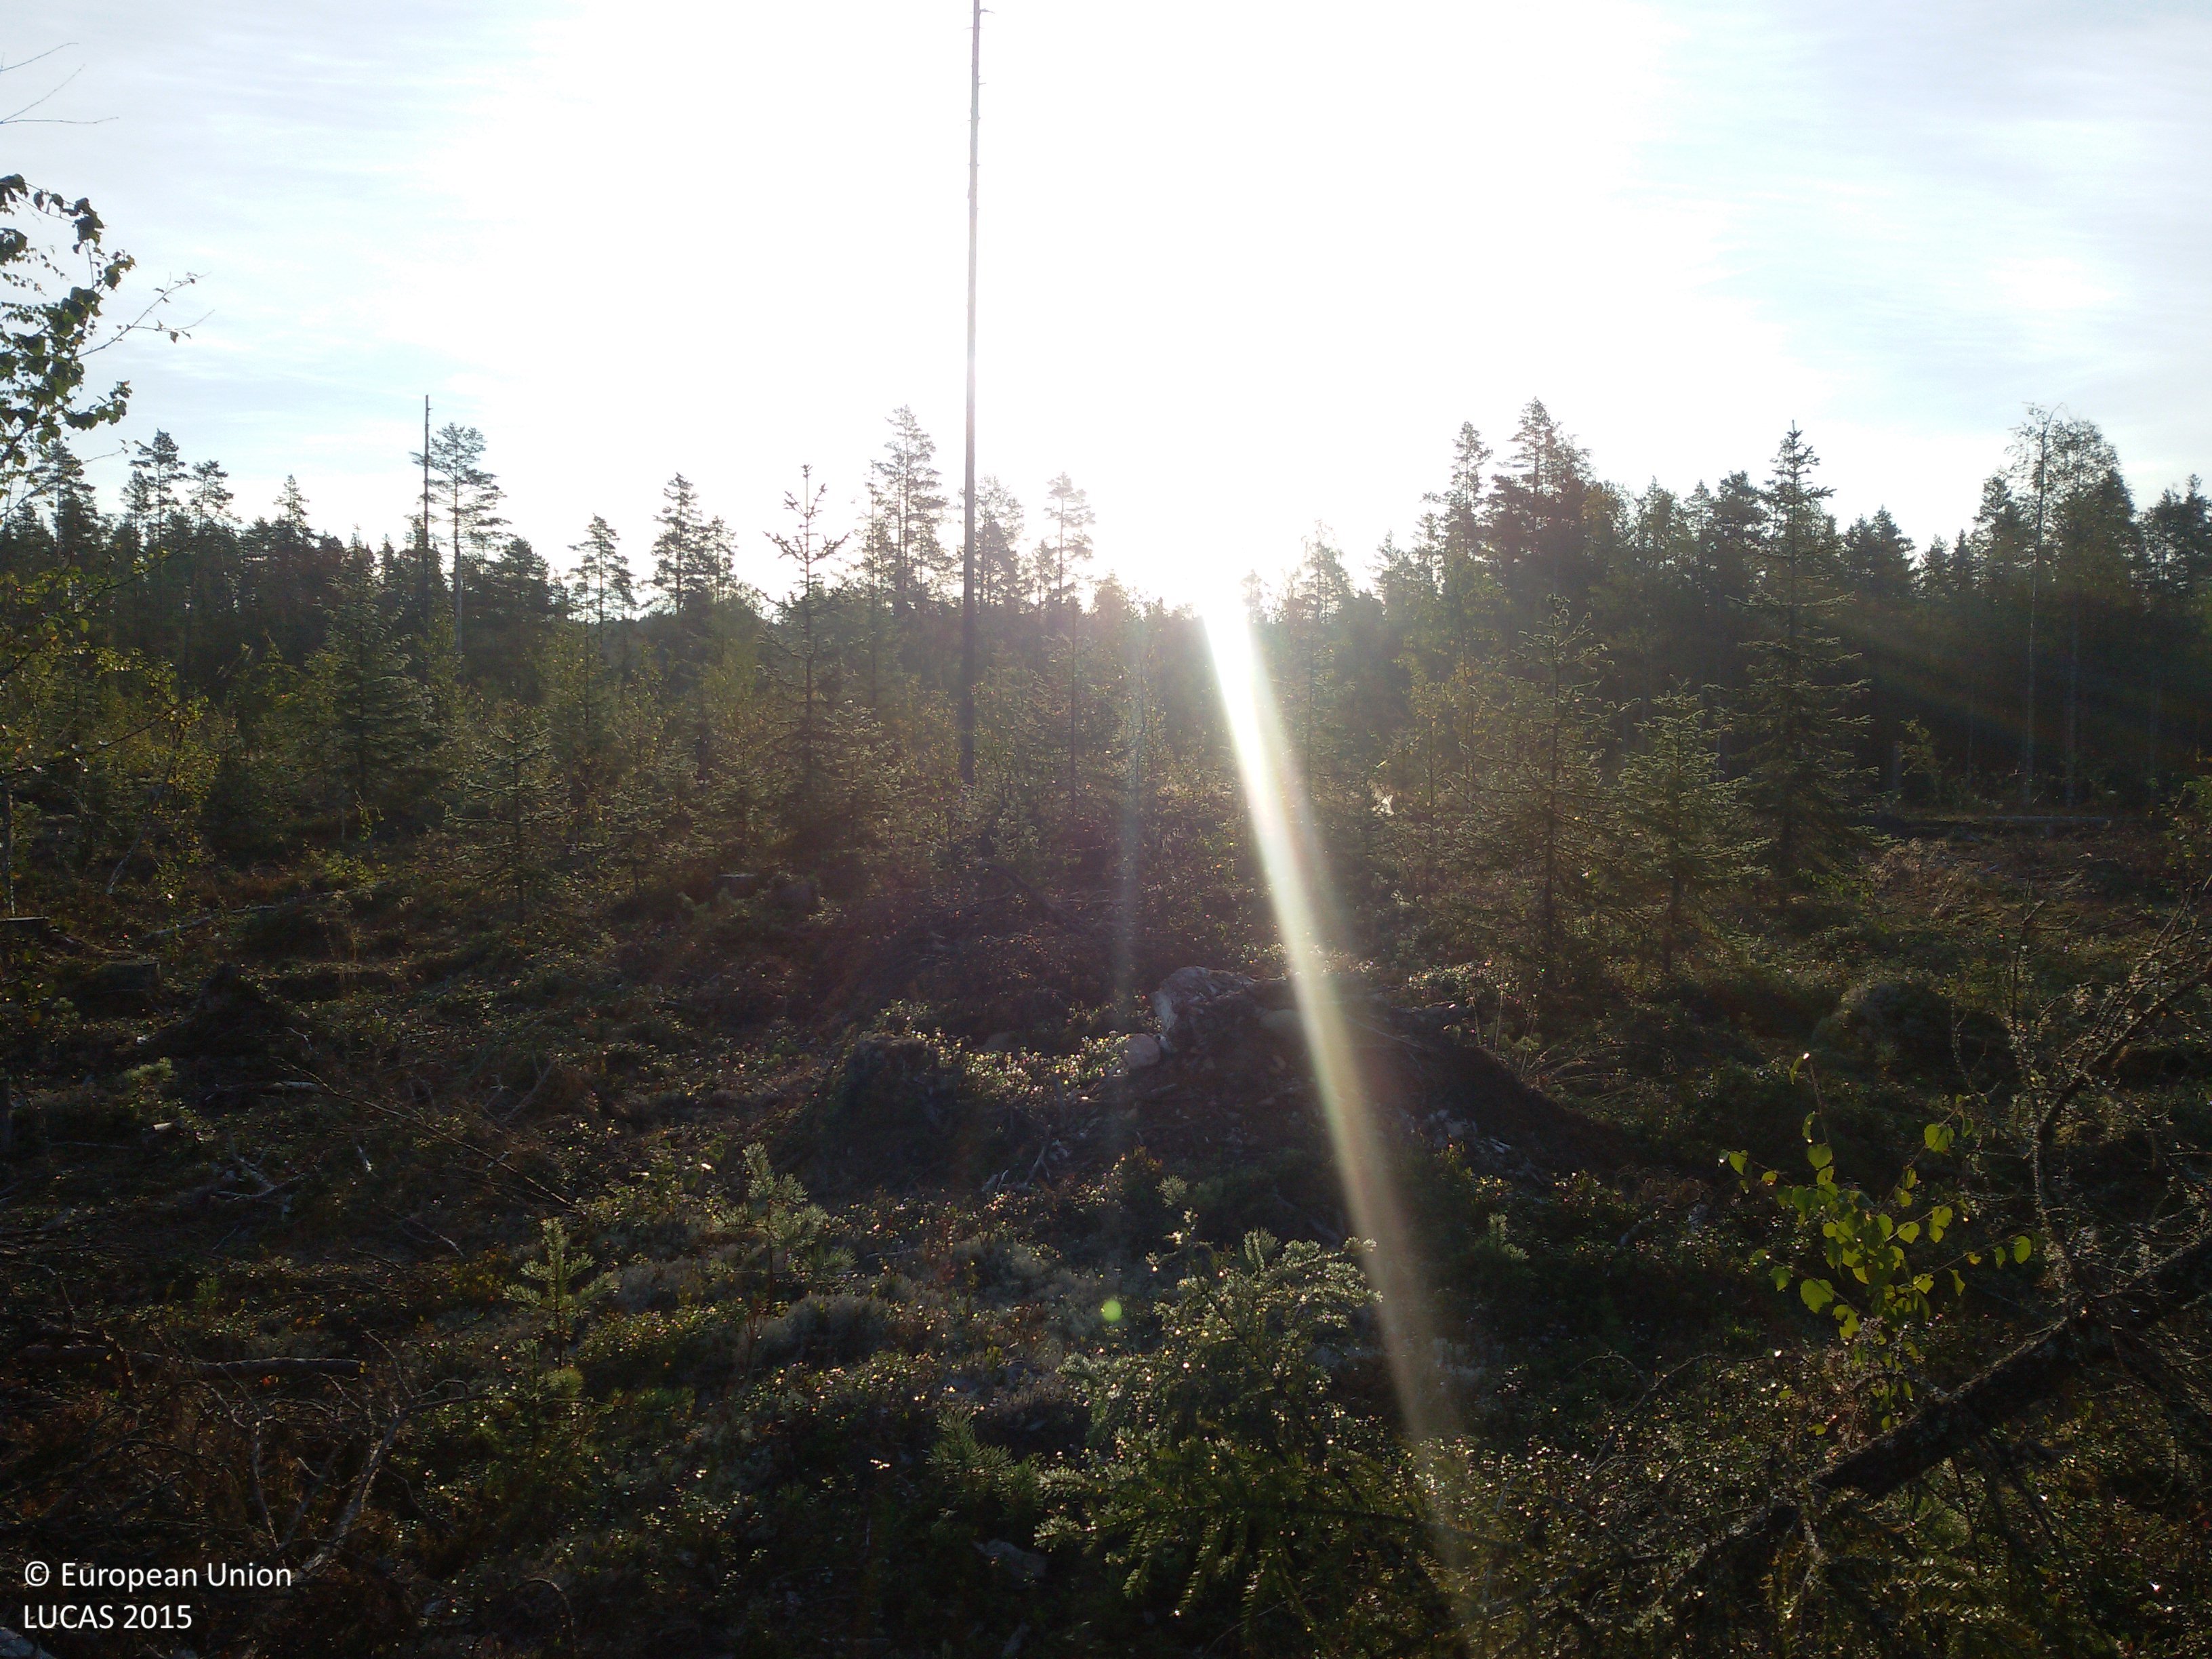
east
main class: Woodland
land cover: Spruce dominated coniferous woodland
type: boreal forest
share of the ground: 25 - 50 %
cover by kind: herbaceous plants 40 %, lichens and mosses 30 %, coniferous forest trees 25 %, broadleaved forest trees 5 %
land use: Forestry
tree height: < 5 m
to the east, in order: Spruce dominated coniferous woodland; Tracks; Spruce dominated coniferous woodland; Inland fresh running water; Pine dominated mixed woodland; Spruce dominated mixed woodland
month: September
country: SE
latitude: 61.0112
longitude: 15.0358
